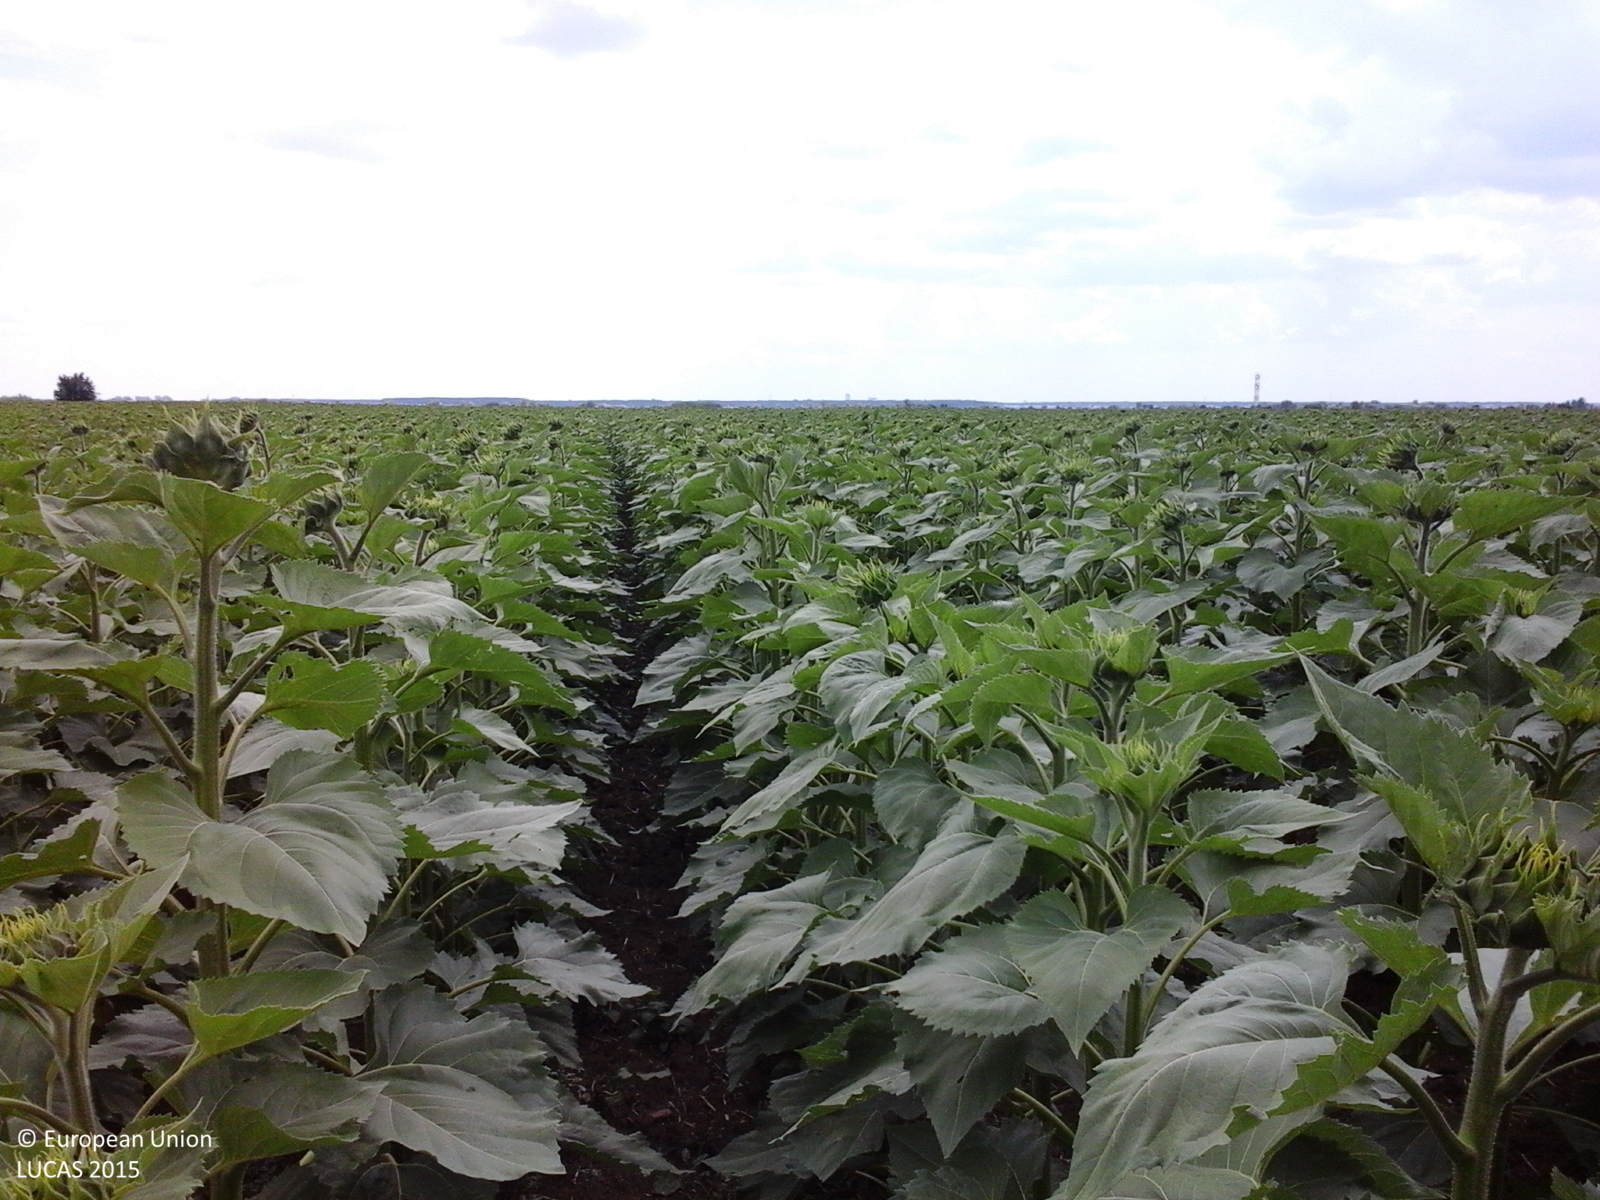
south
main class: Cropland
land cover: Sunflower
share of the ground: > 75 %
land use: Agriculture (excluding fallow land and kitchen gardens)
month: June
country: RO
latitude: 44.5866
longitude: 26.1160
